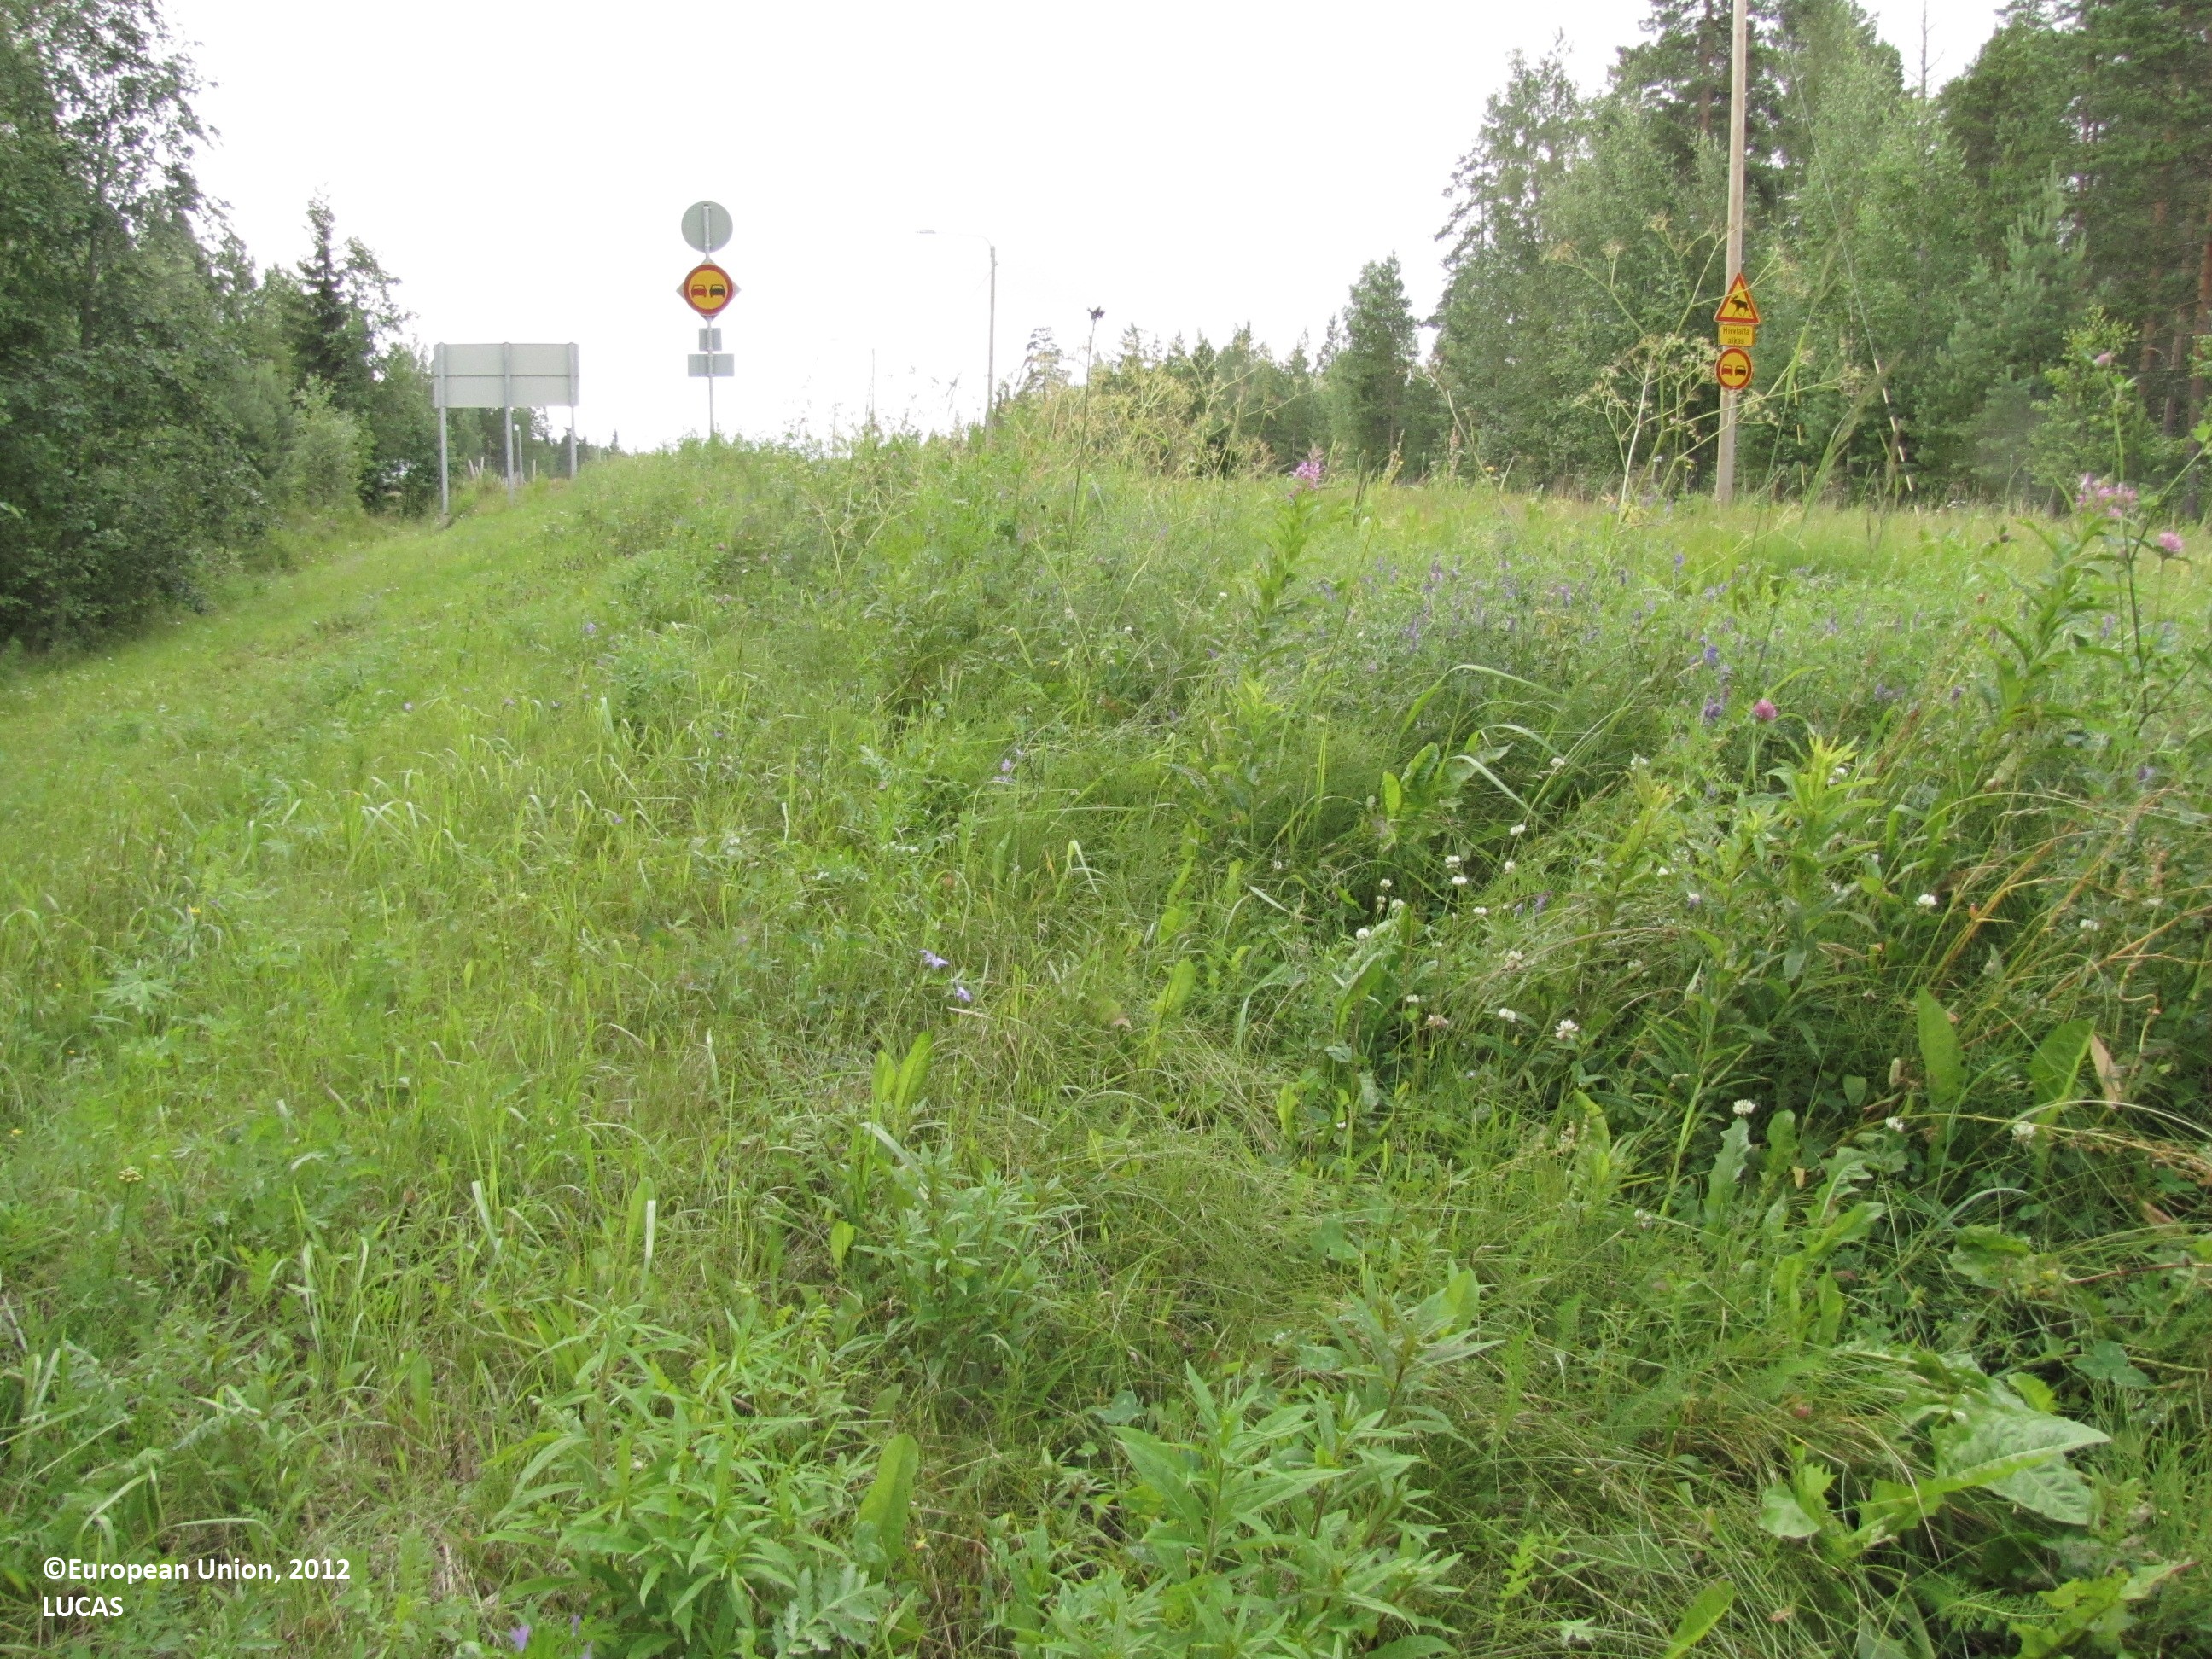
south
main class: Grassland
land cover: Grassland without tree/shrub cover
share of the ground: > 75 %
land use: Road transport
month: July
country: FI
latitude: 62.2731
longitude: 22.9143
